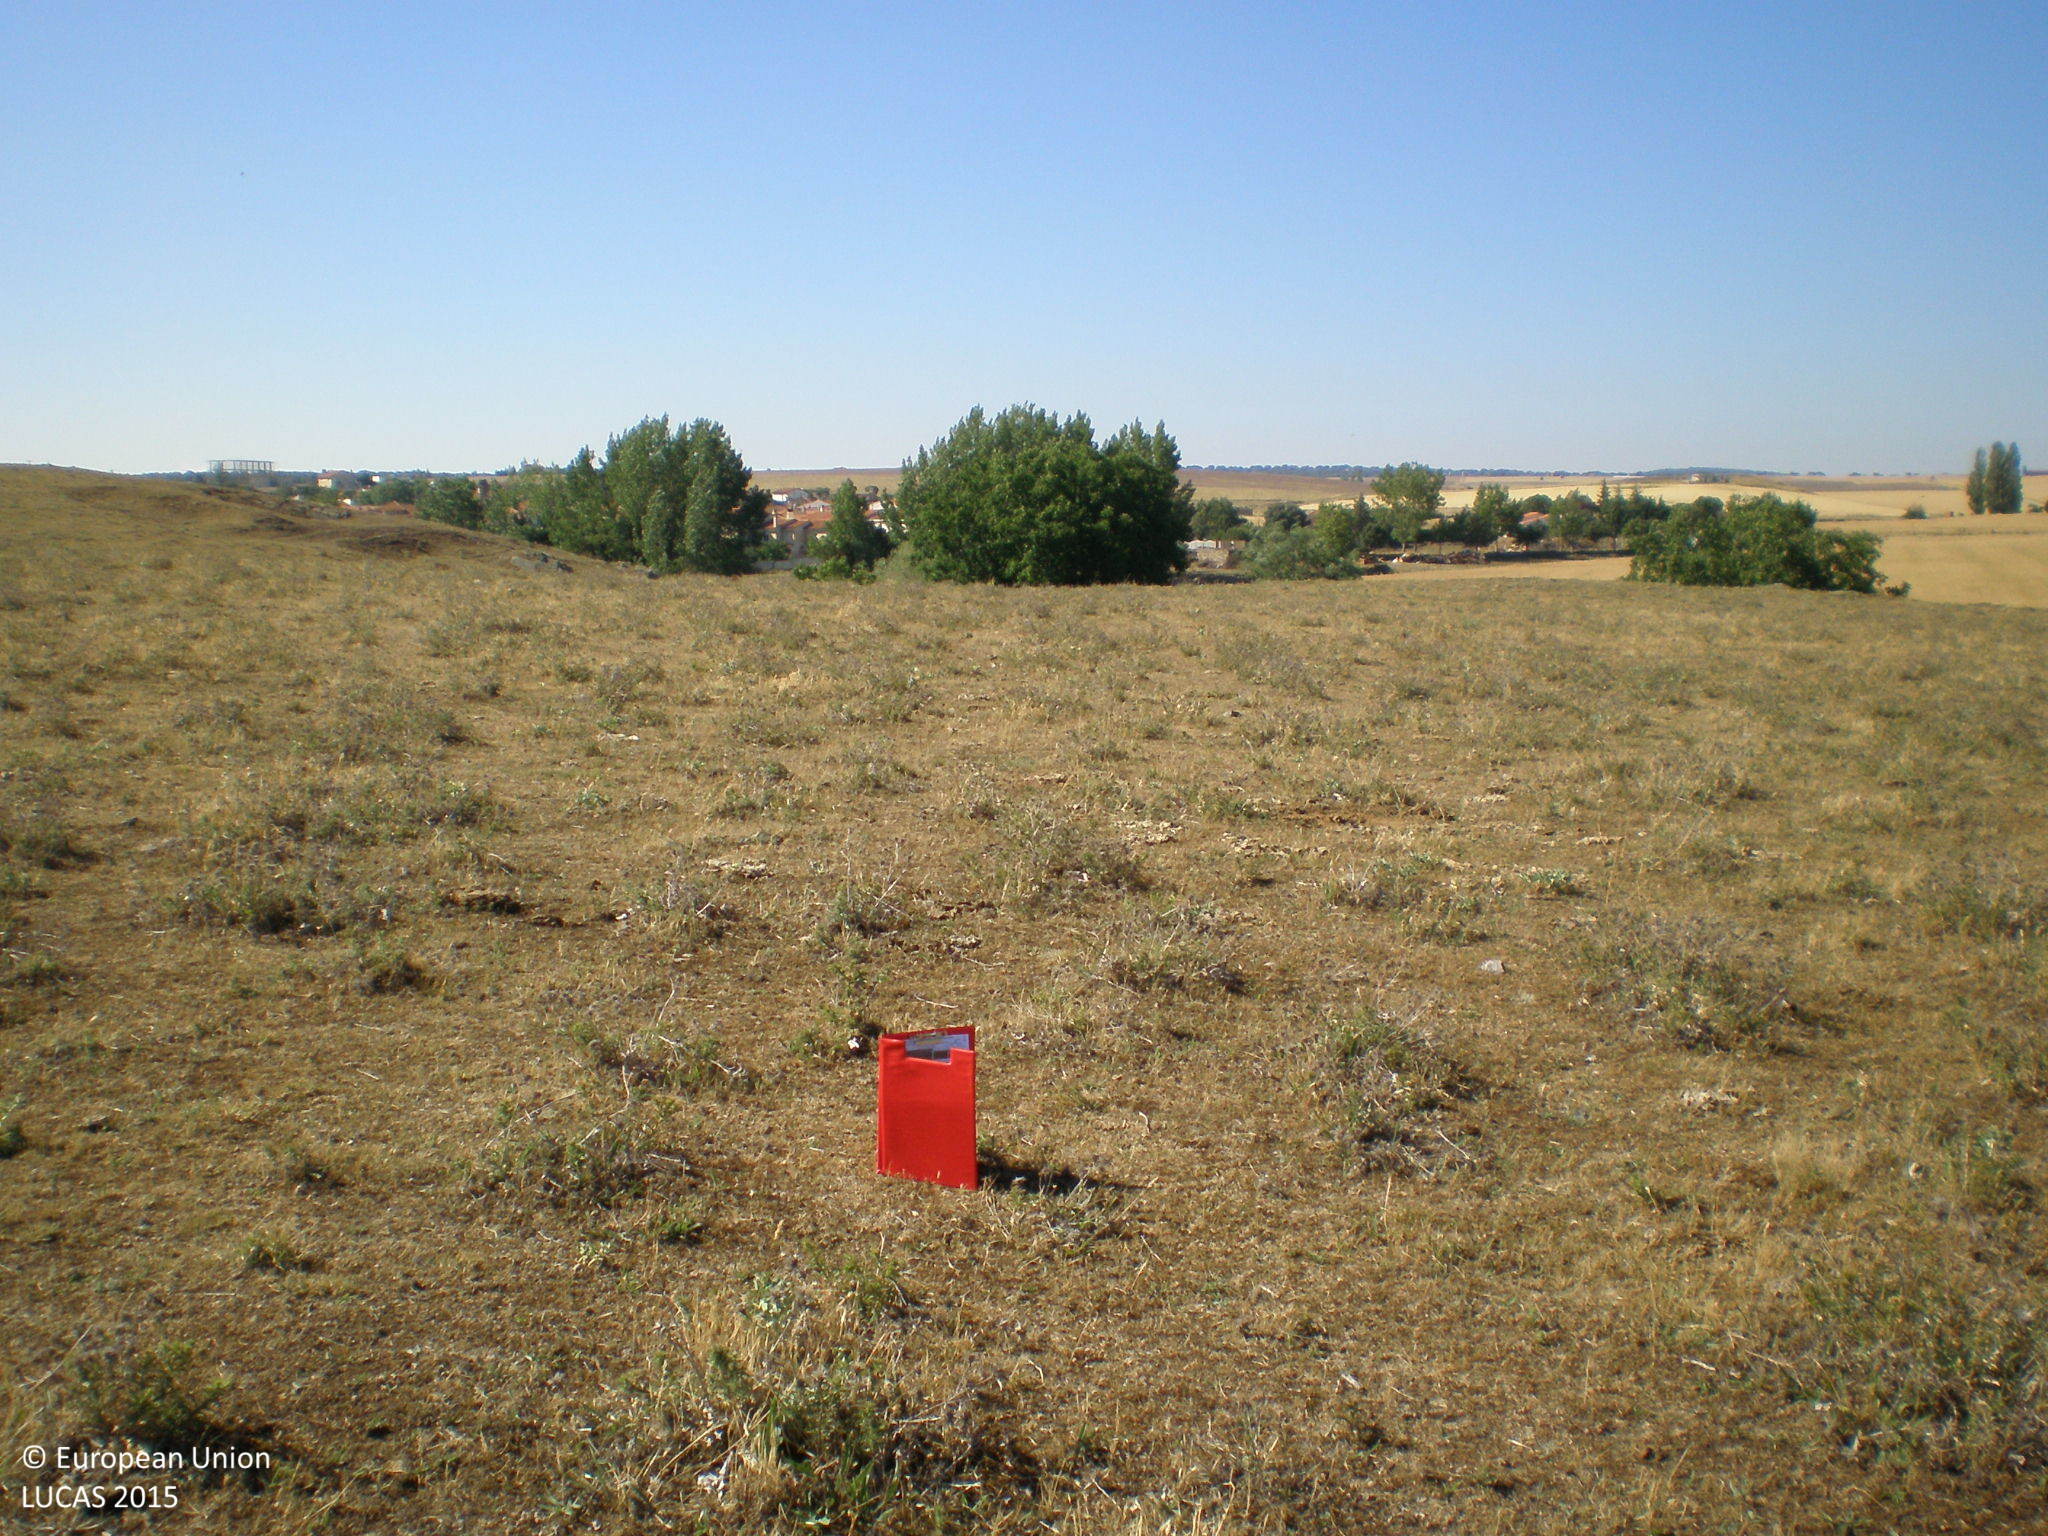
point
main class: Grassland
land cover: Grassland without tree/shrub cover
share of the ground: > 75 %
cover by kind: herbaceous plants 100 %
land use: Agriculture (excluding fallow land and kitchen gardens)
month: June
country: ES
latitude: 40.8906
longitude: -5.6841
